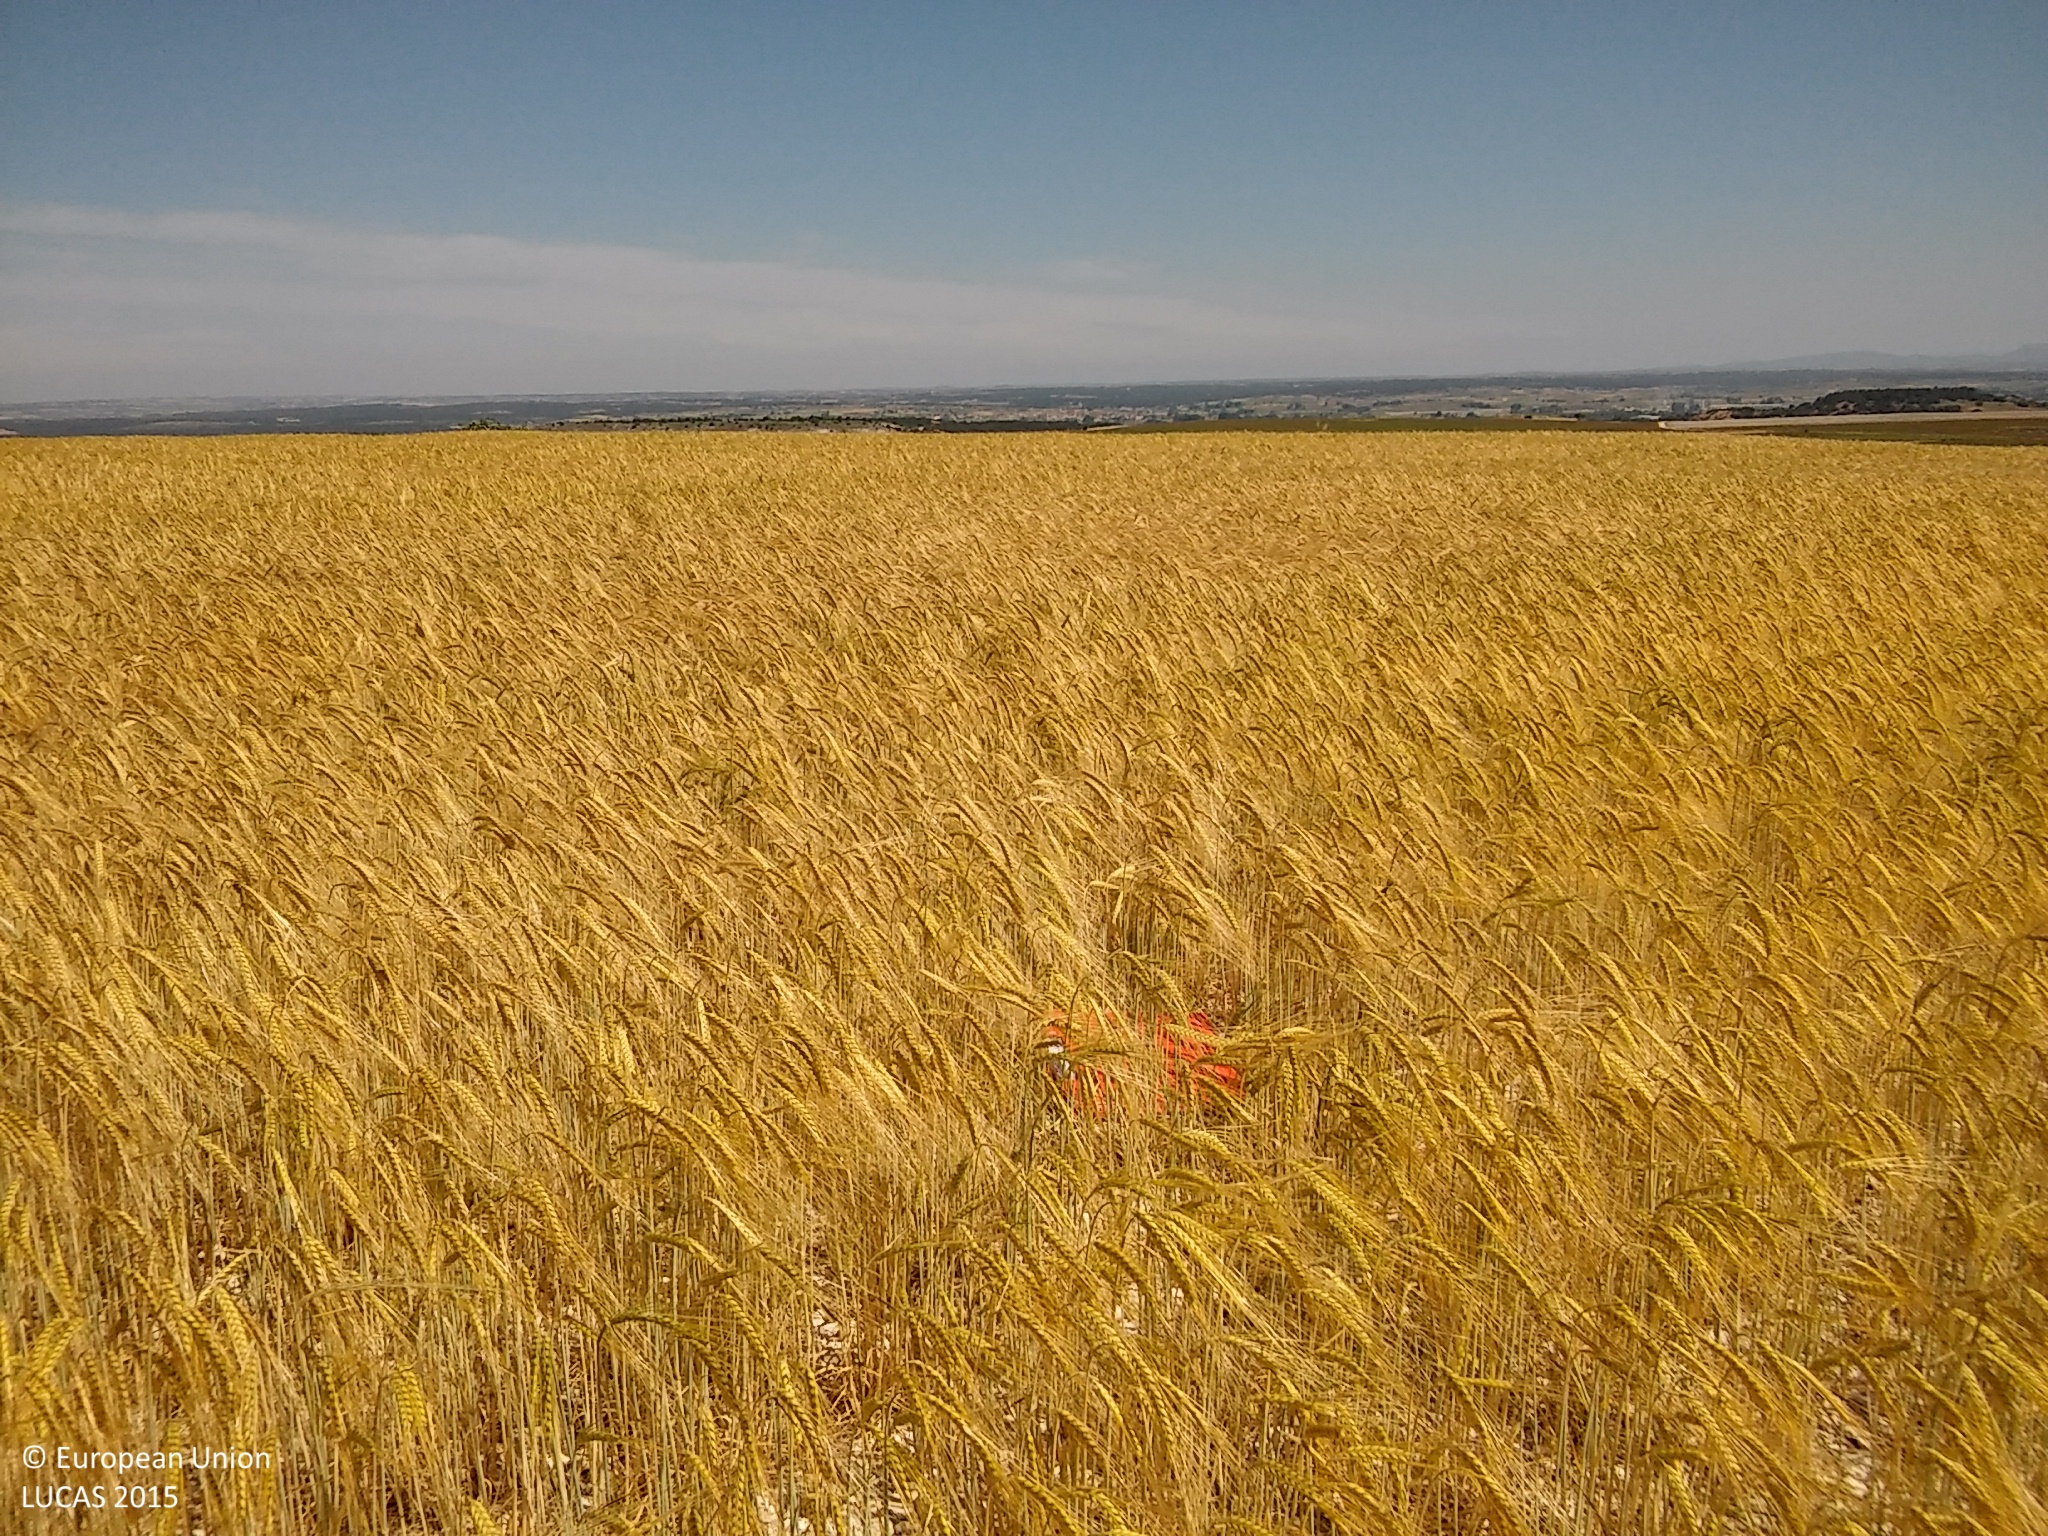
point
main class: Cropland
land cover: Barley
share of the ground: > 75 %
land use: Agriculture (excluding fallow land and kitchen gardens)
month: June
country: ES
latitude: 41.6202
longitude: -3.7470
